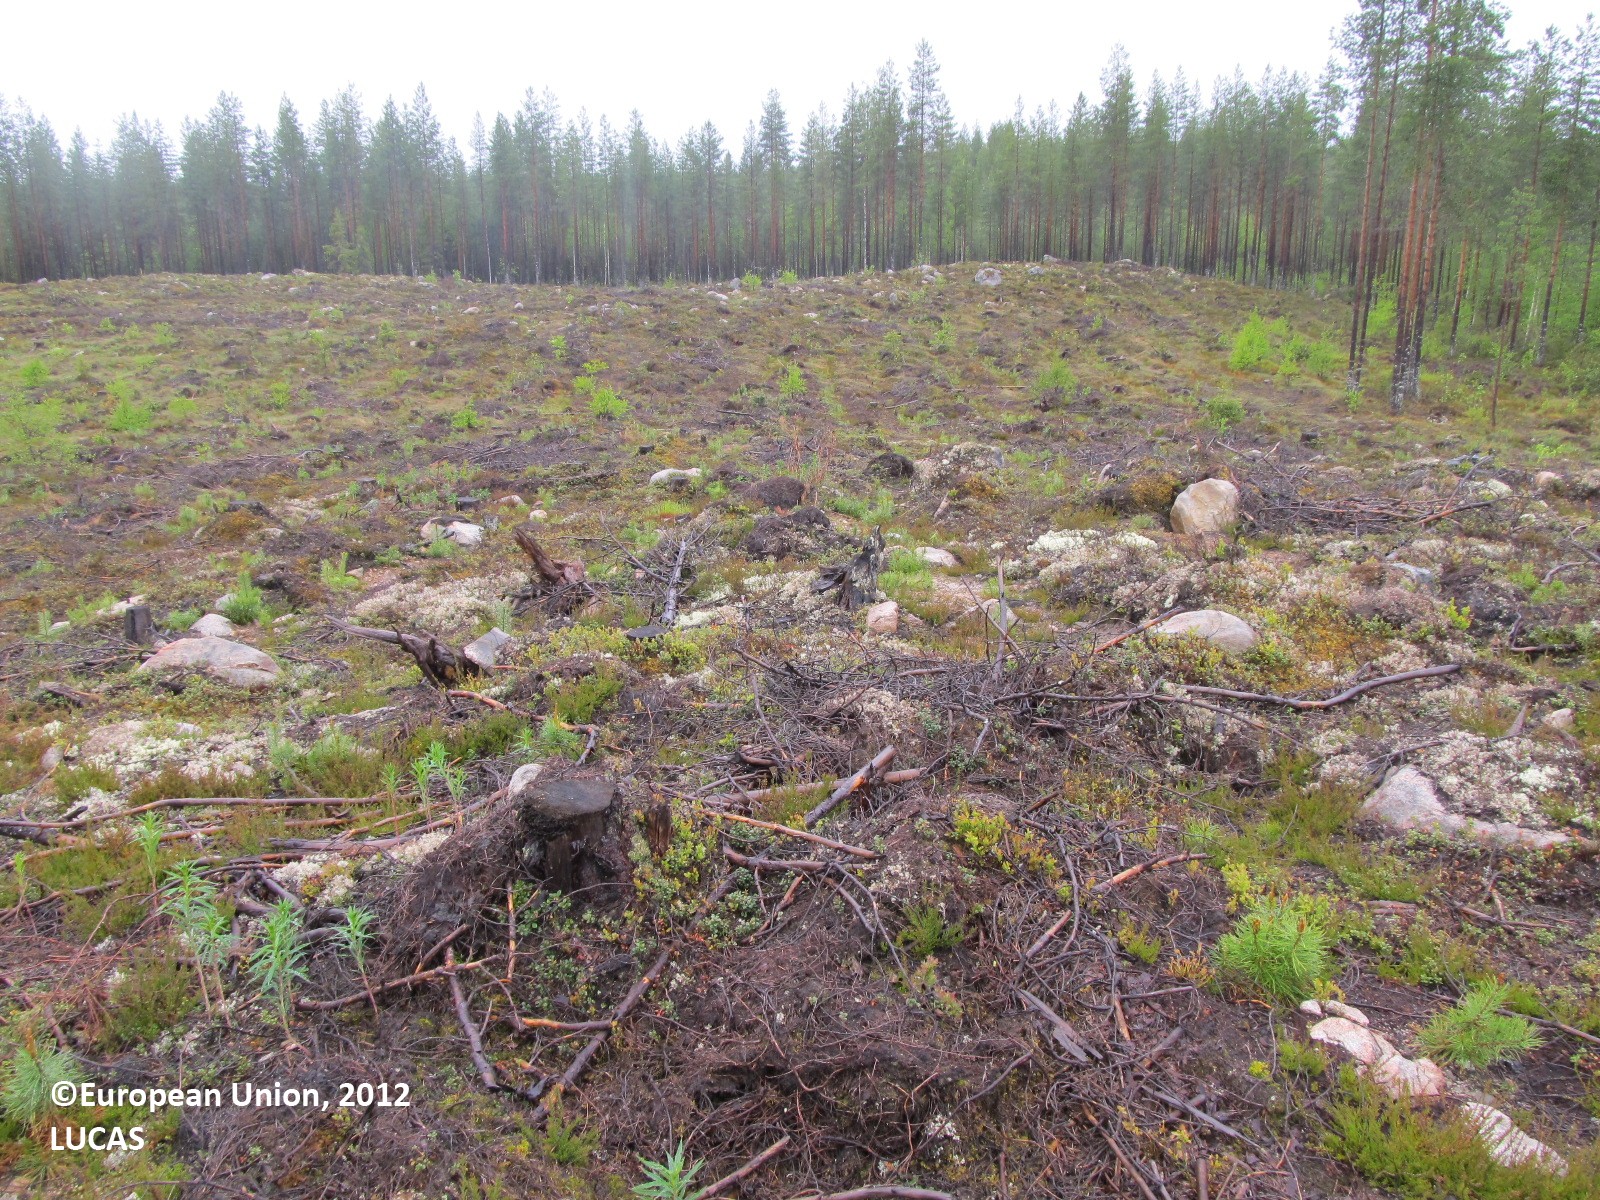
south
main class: Shrubland
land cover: Shrubland without tree cover
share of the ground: 50 - 75 %
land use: Forestry
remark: Clear cut
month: June
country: FI
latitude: 63.3061
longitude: 29.1511
